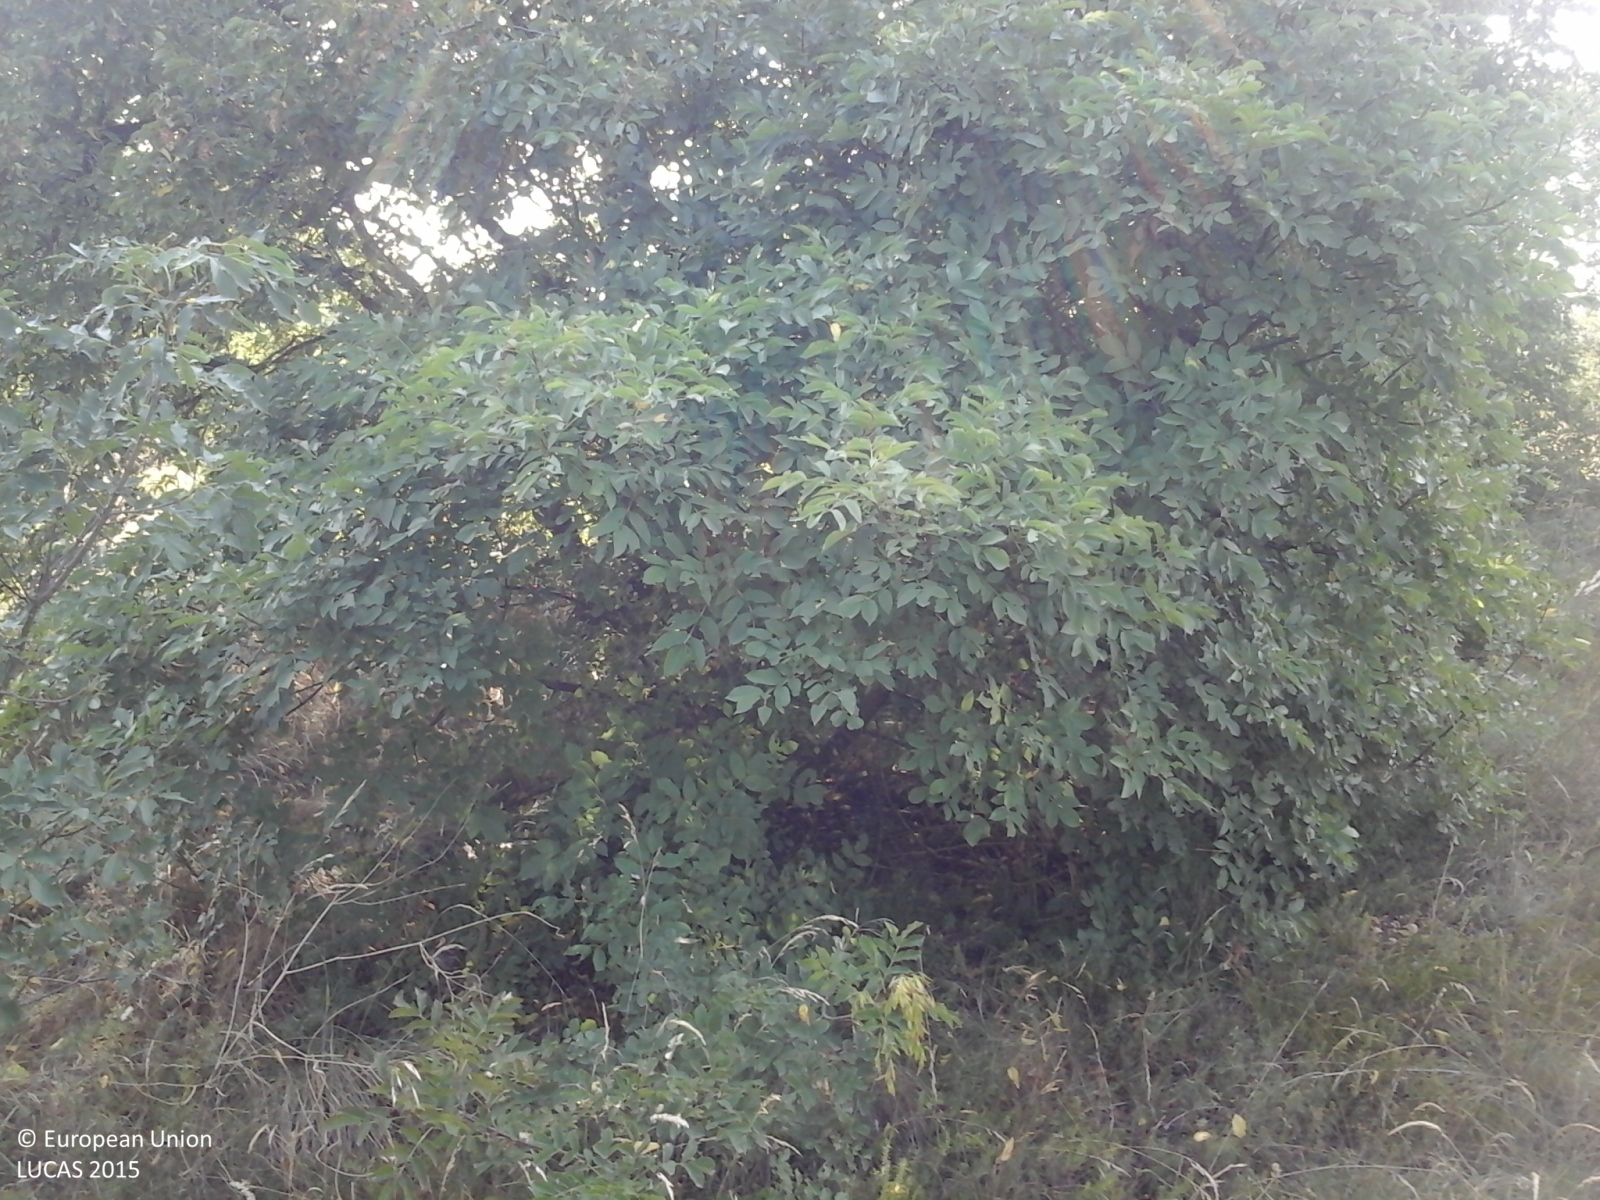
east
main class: Grassland
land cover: Grassland with sparse tree/shrub cover
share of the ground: > 75 %
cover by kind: herbaceous plants 85 %, shrubs 10 %, broadleaved forest trees 5 %
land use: Agriculture (excluding fallow land and kitchen gardens)
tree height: < 5 m
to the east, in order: Grassland with sparse tree/shrub cover; Broadleaved woodland; Electric lines; Broadleaved woodland; Dry stone walls; Olive groves; Dry stone walls; Olive groves; Dry stone walls; Olive groves; Dry stone walls; Olive groves; Dry stone walls; Olive groves; Dry stone walls; Olive groves; Dry stone walls; Olive groves; Dry stone walls; Other bare soil; Broadleaved woodland; Shrubland with sparse tree cover
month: July
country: IT
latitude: 45.4818
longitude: 10.9834
